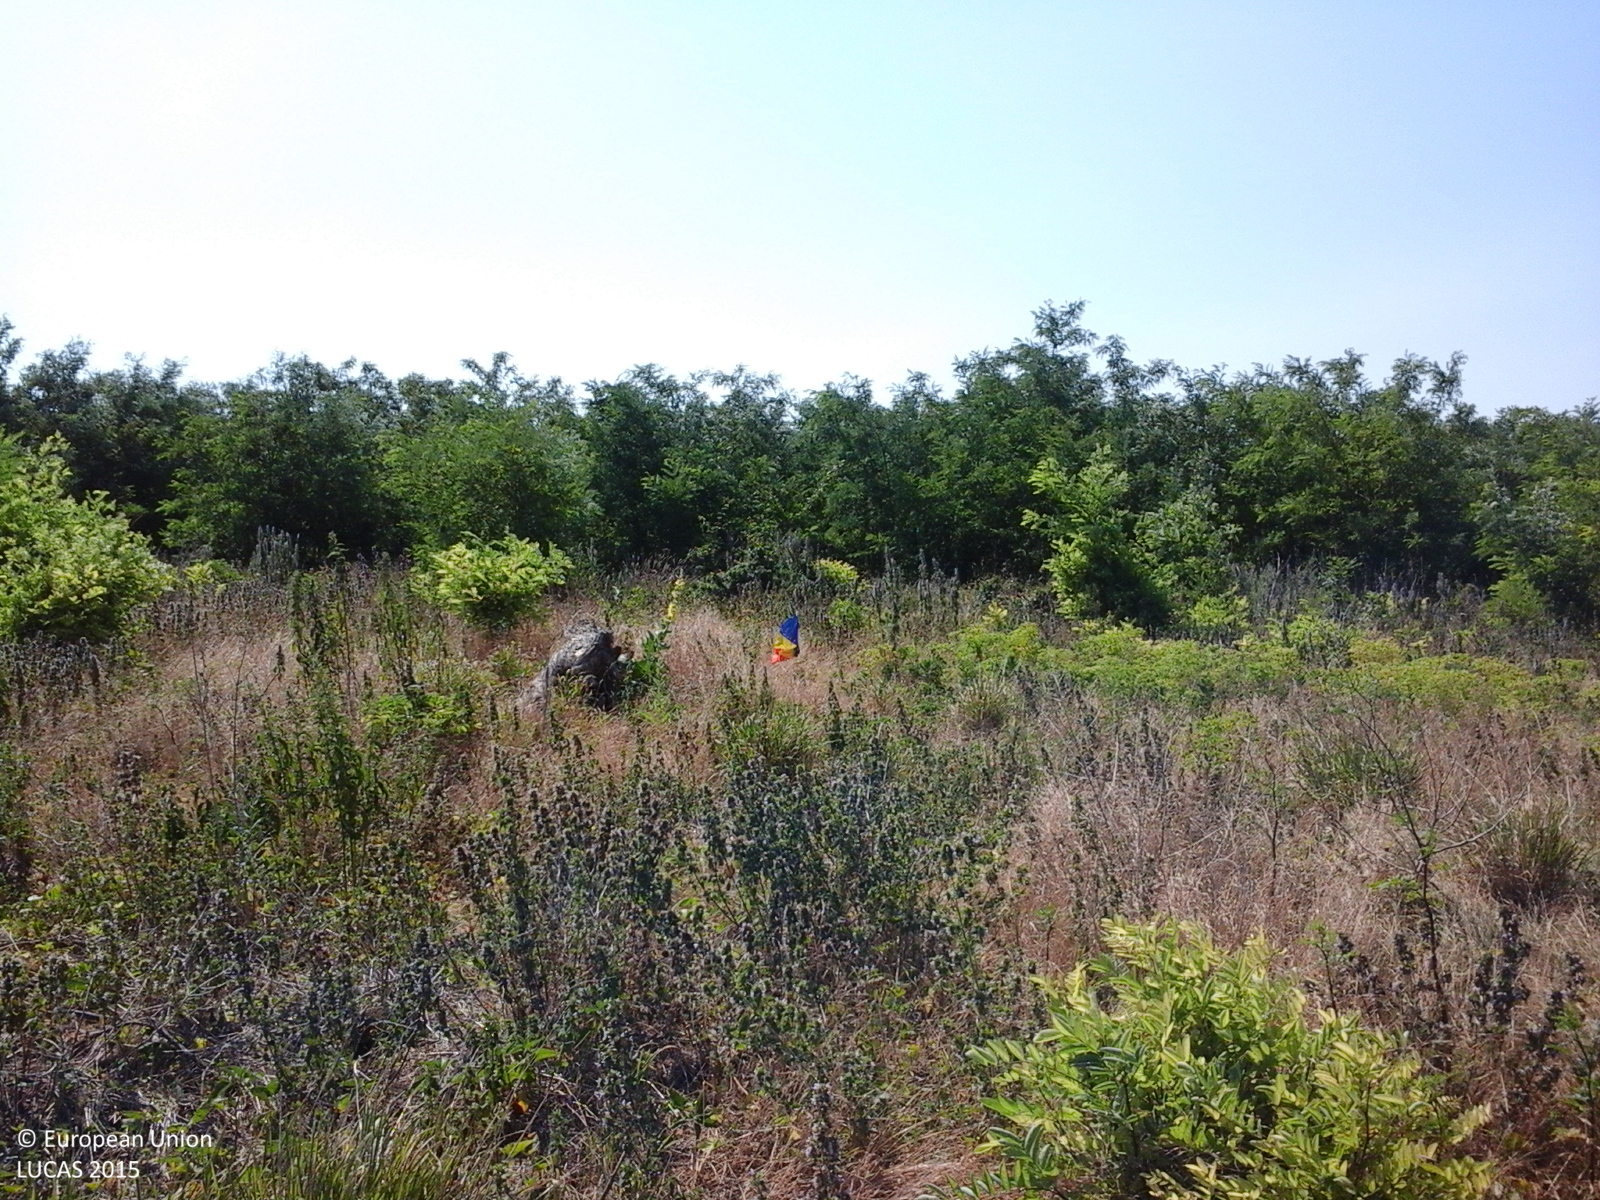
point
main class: Shrubland
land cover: Shrubland with sparse tree cover
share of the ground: > 75 %
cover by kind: shrubs 65 %, herbaceous plants 30 %, broadleaved forest trees 5 %
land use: Semi-natural and natural areas not in use
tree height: < 5 m
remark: Clear cut
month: June
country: RO
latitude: 46.9055
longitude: 28.0240
